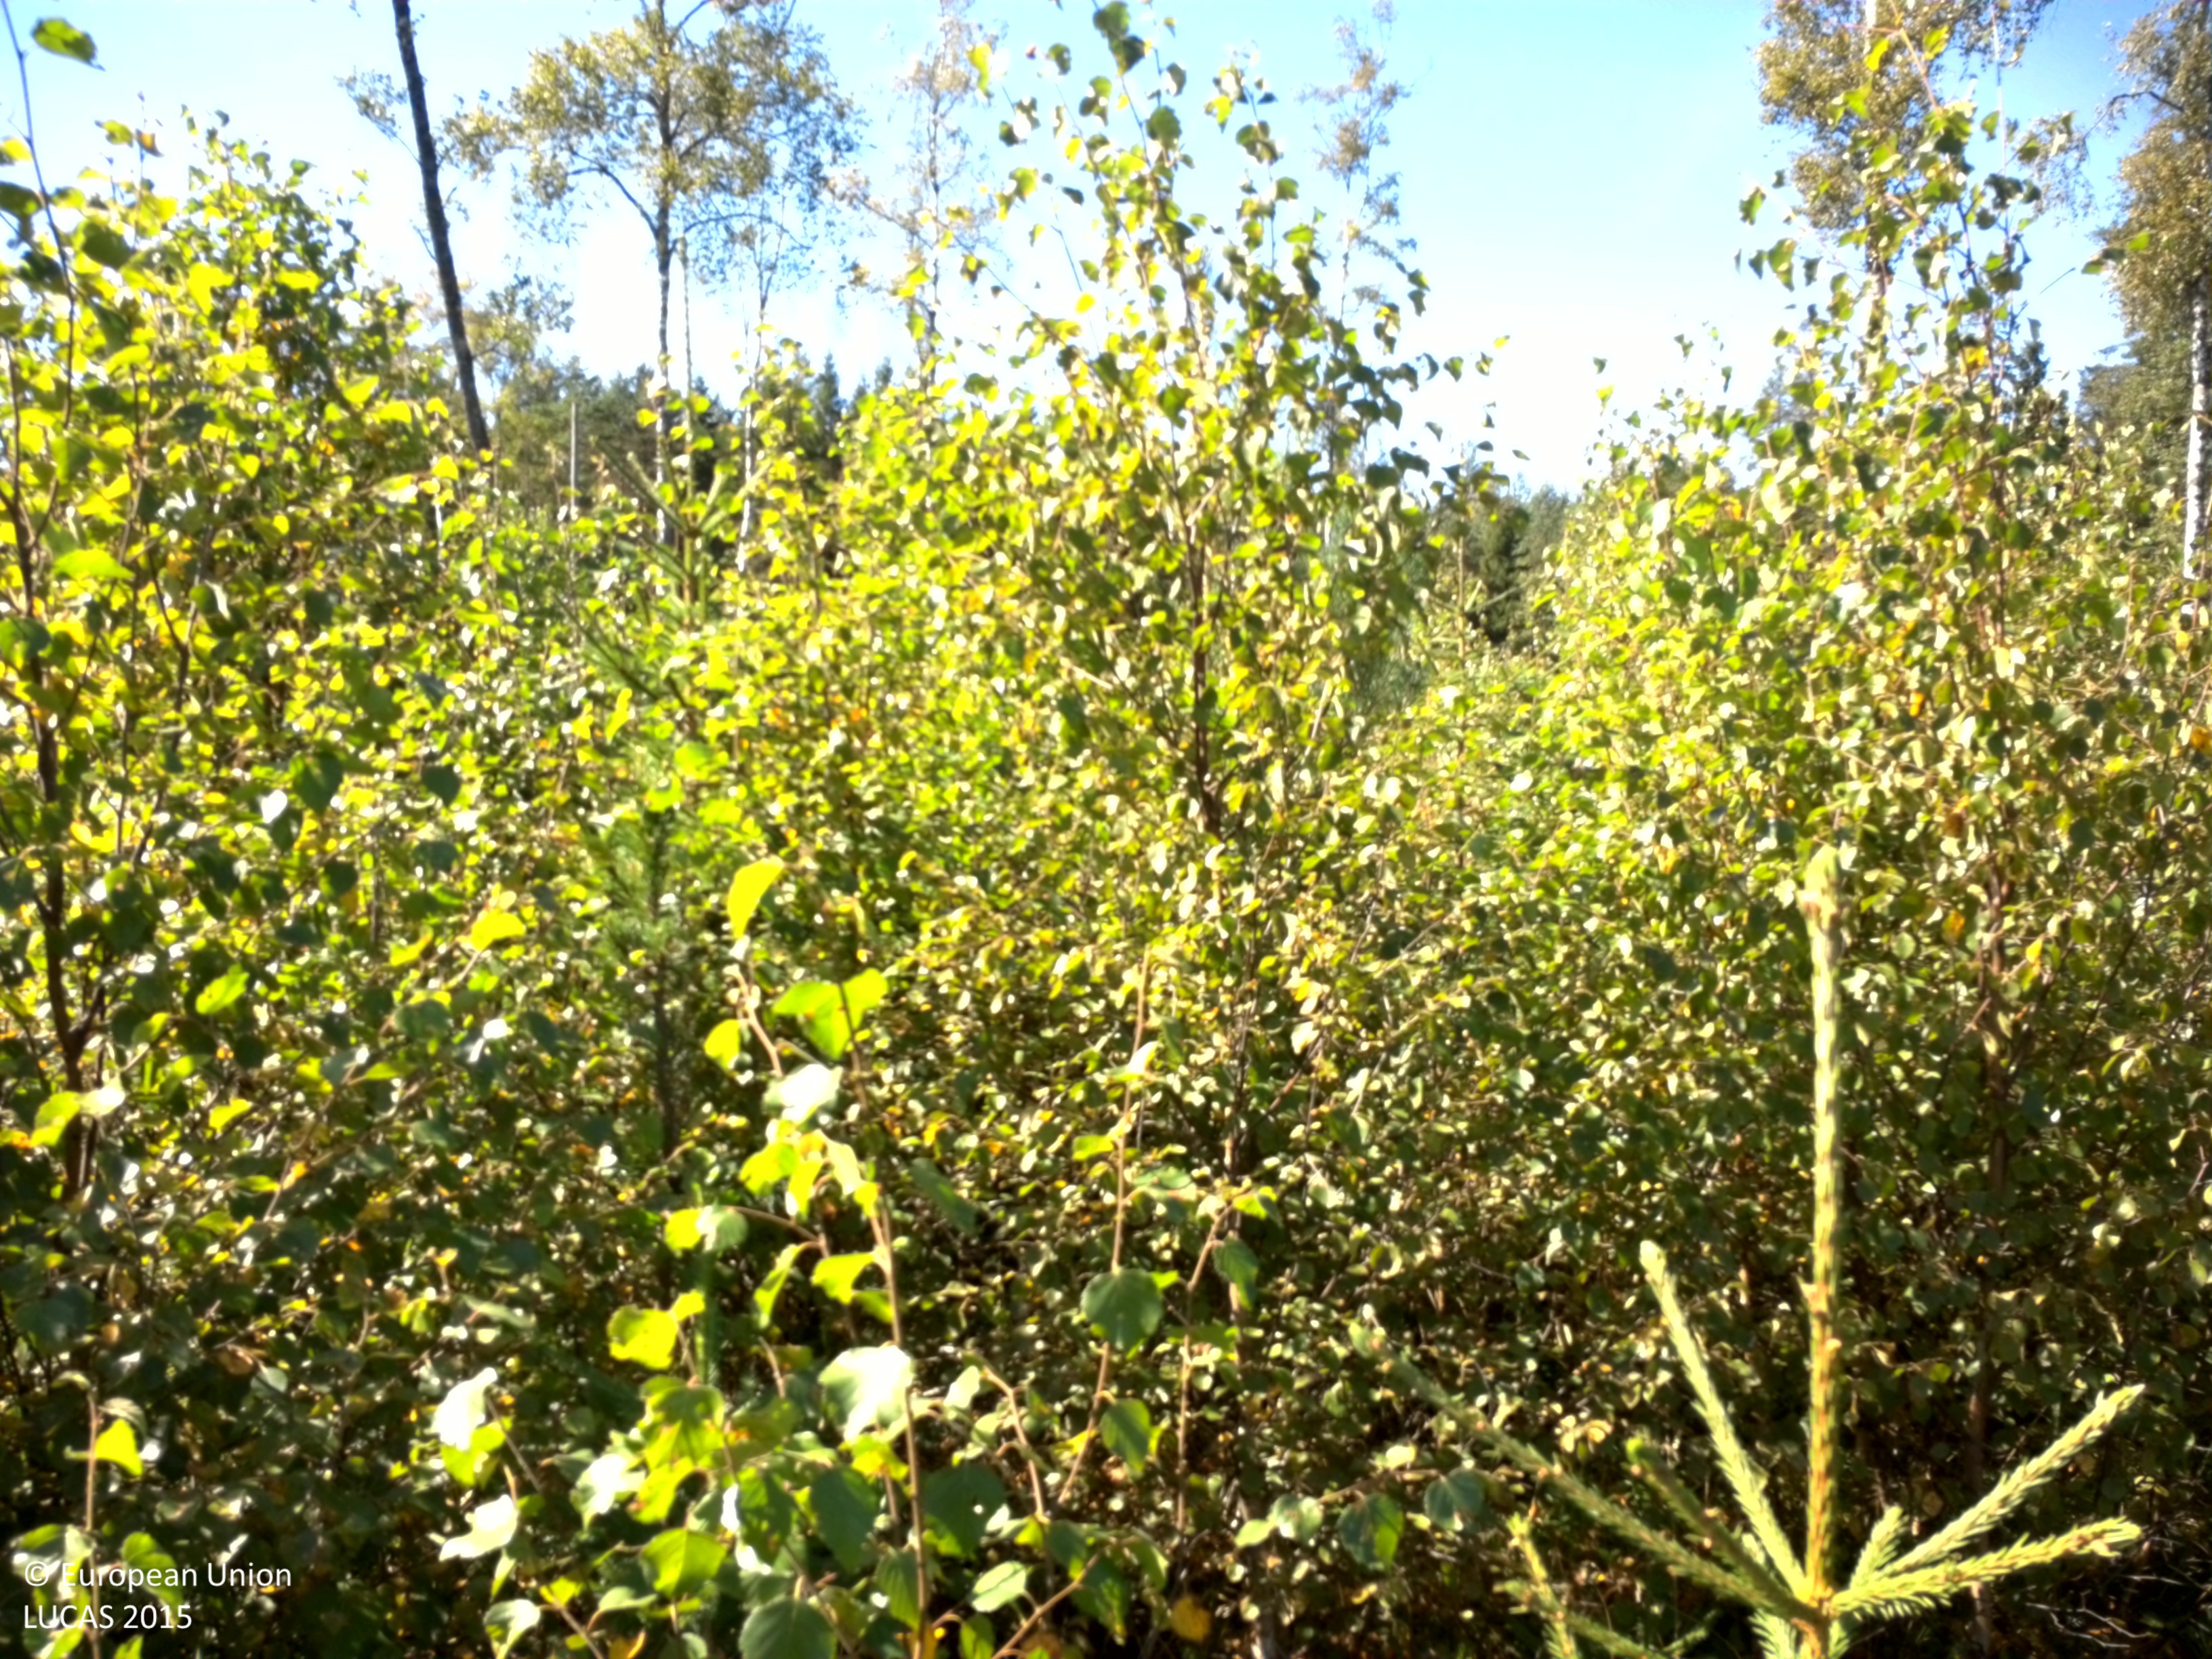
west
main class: Woodland
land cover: Spruce dominated mixed woodland
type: boreal forest
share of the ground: 25 - 50 %
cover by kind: coniferous forest trees 30 %, herbaceous plants 30 %, broadleaved forest trees 20 %, lichens and mosses 20 %
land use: Forestry
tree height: < 5 m
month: August
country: SE
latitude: 60.0309
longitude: 17.9092
